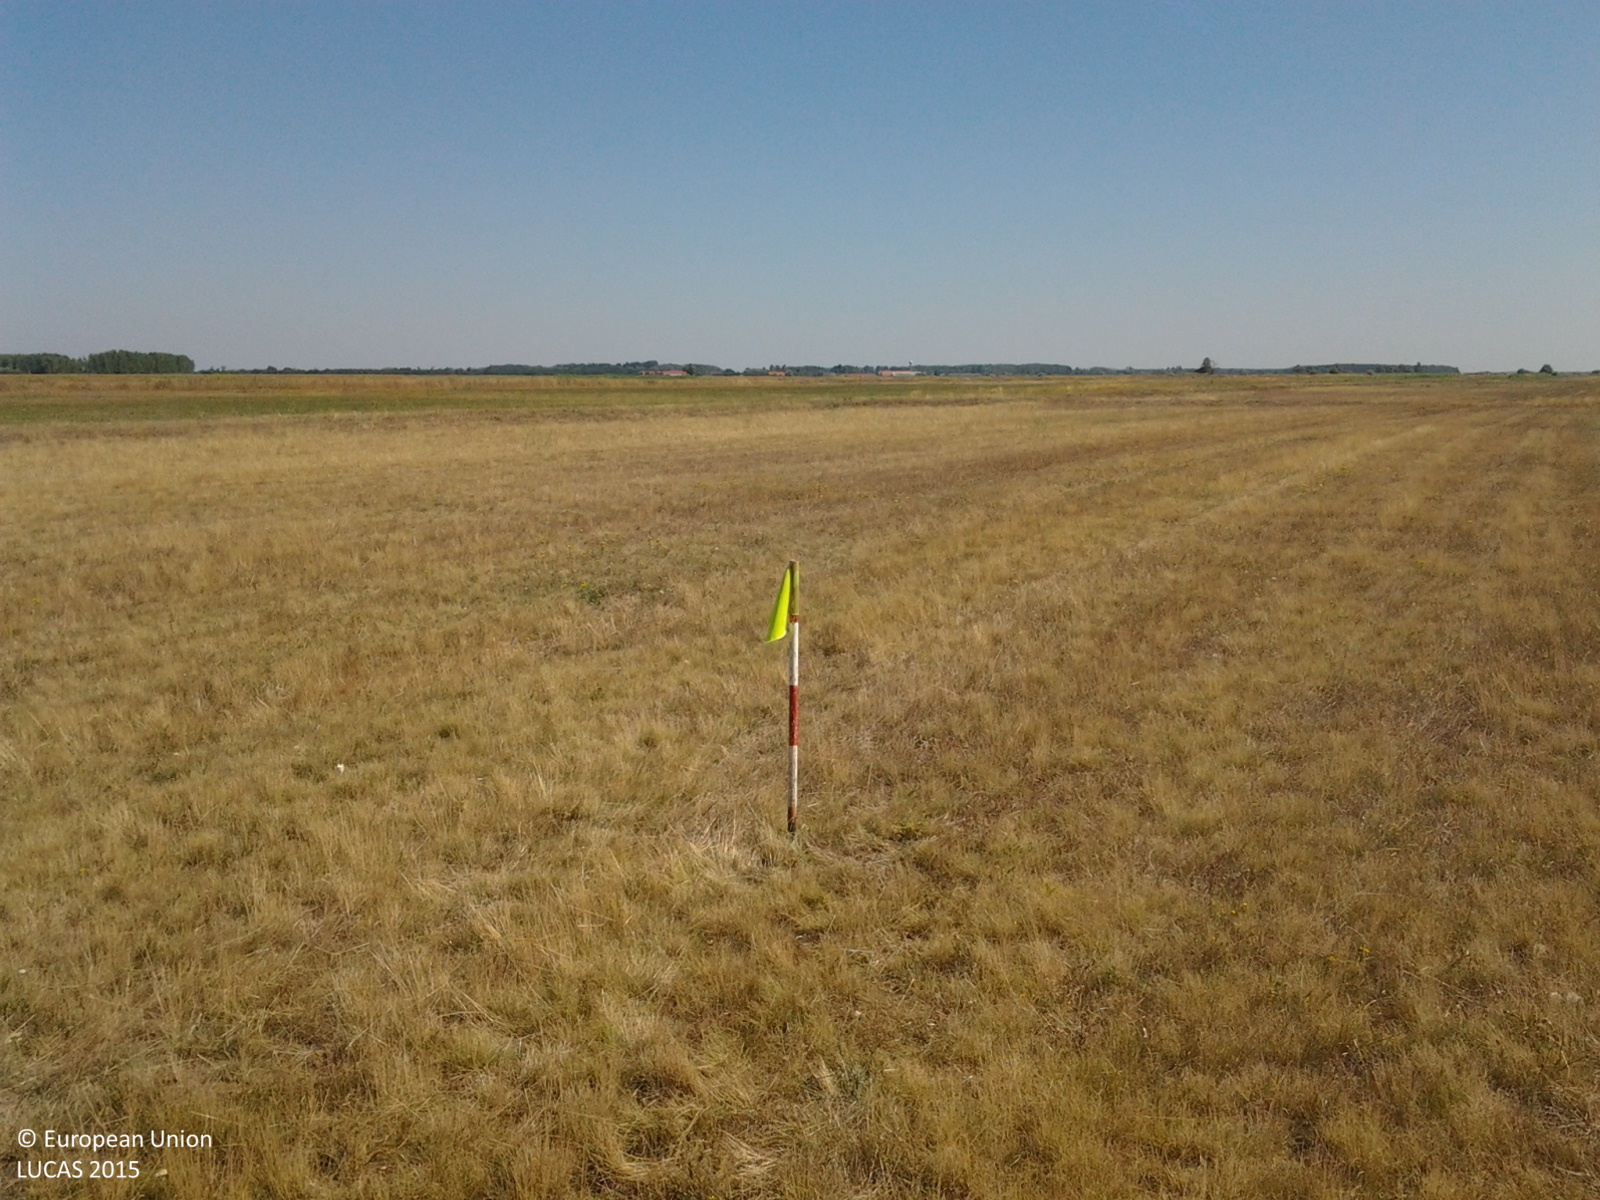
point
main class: Grassland
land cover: Grassland without tree/shrub cover
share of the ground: > 75 %
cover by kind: herbaceous plants 100 %
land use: Agriculture (excluding fallow land and kitchen gardens)
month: July
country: HU
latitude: 47.3372
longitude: 20.5255
